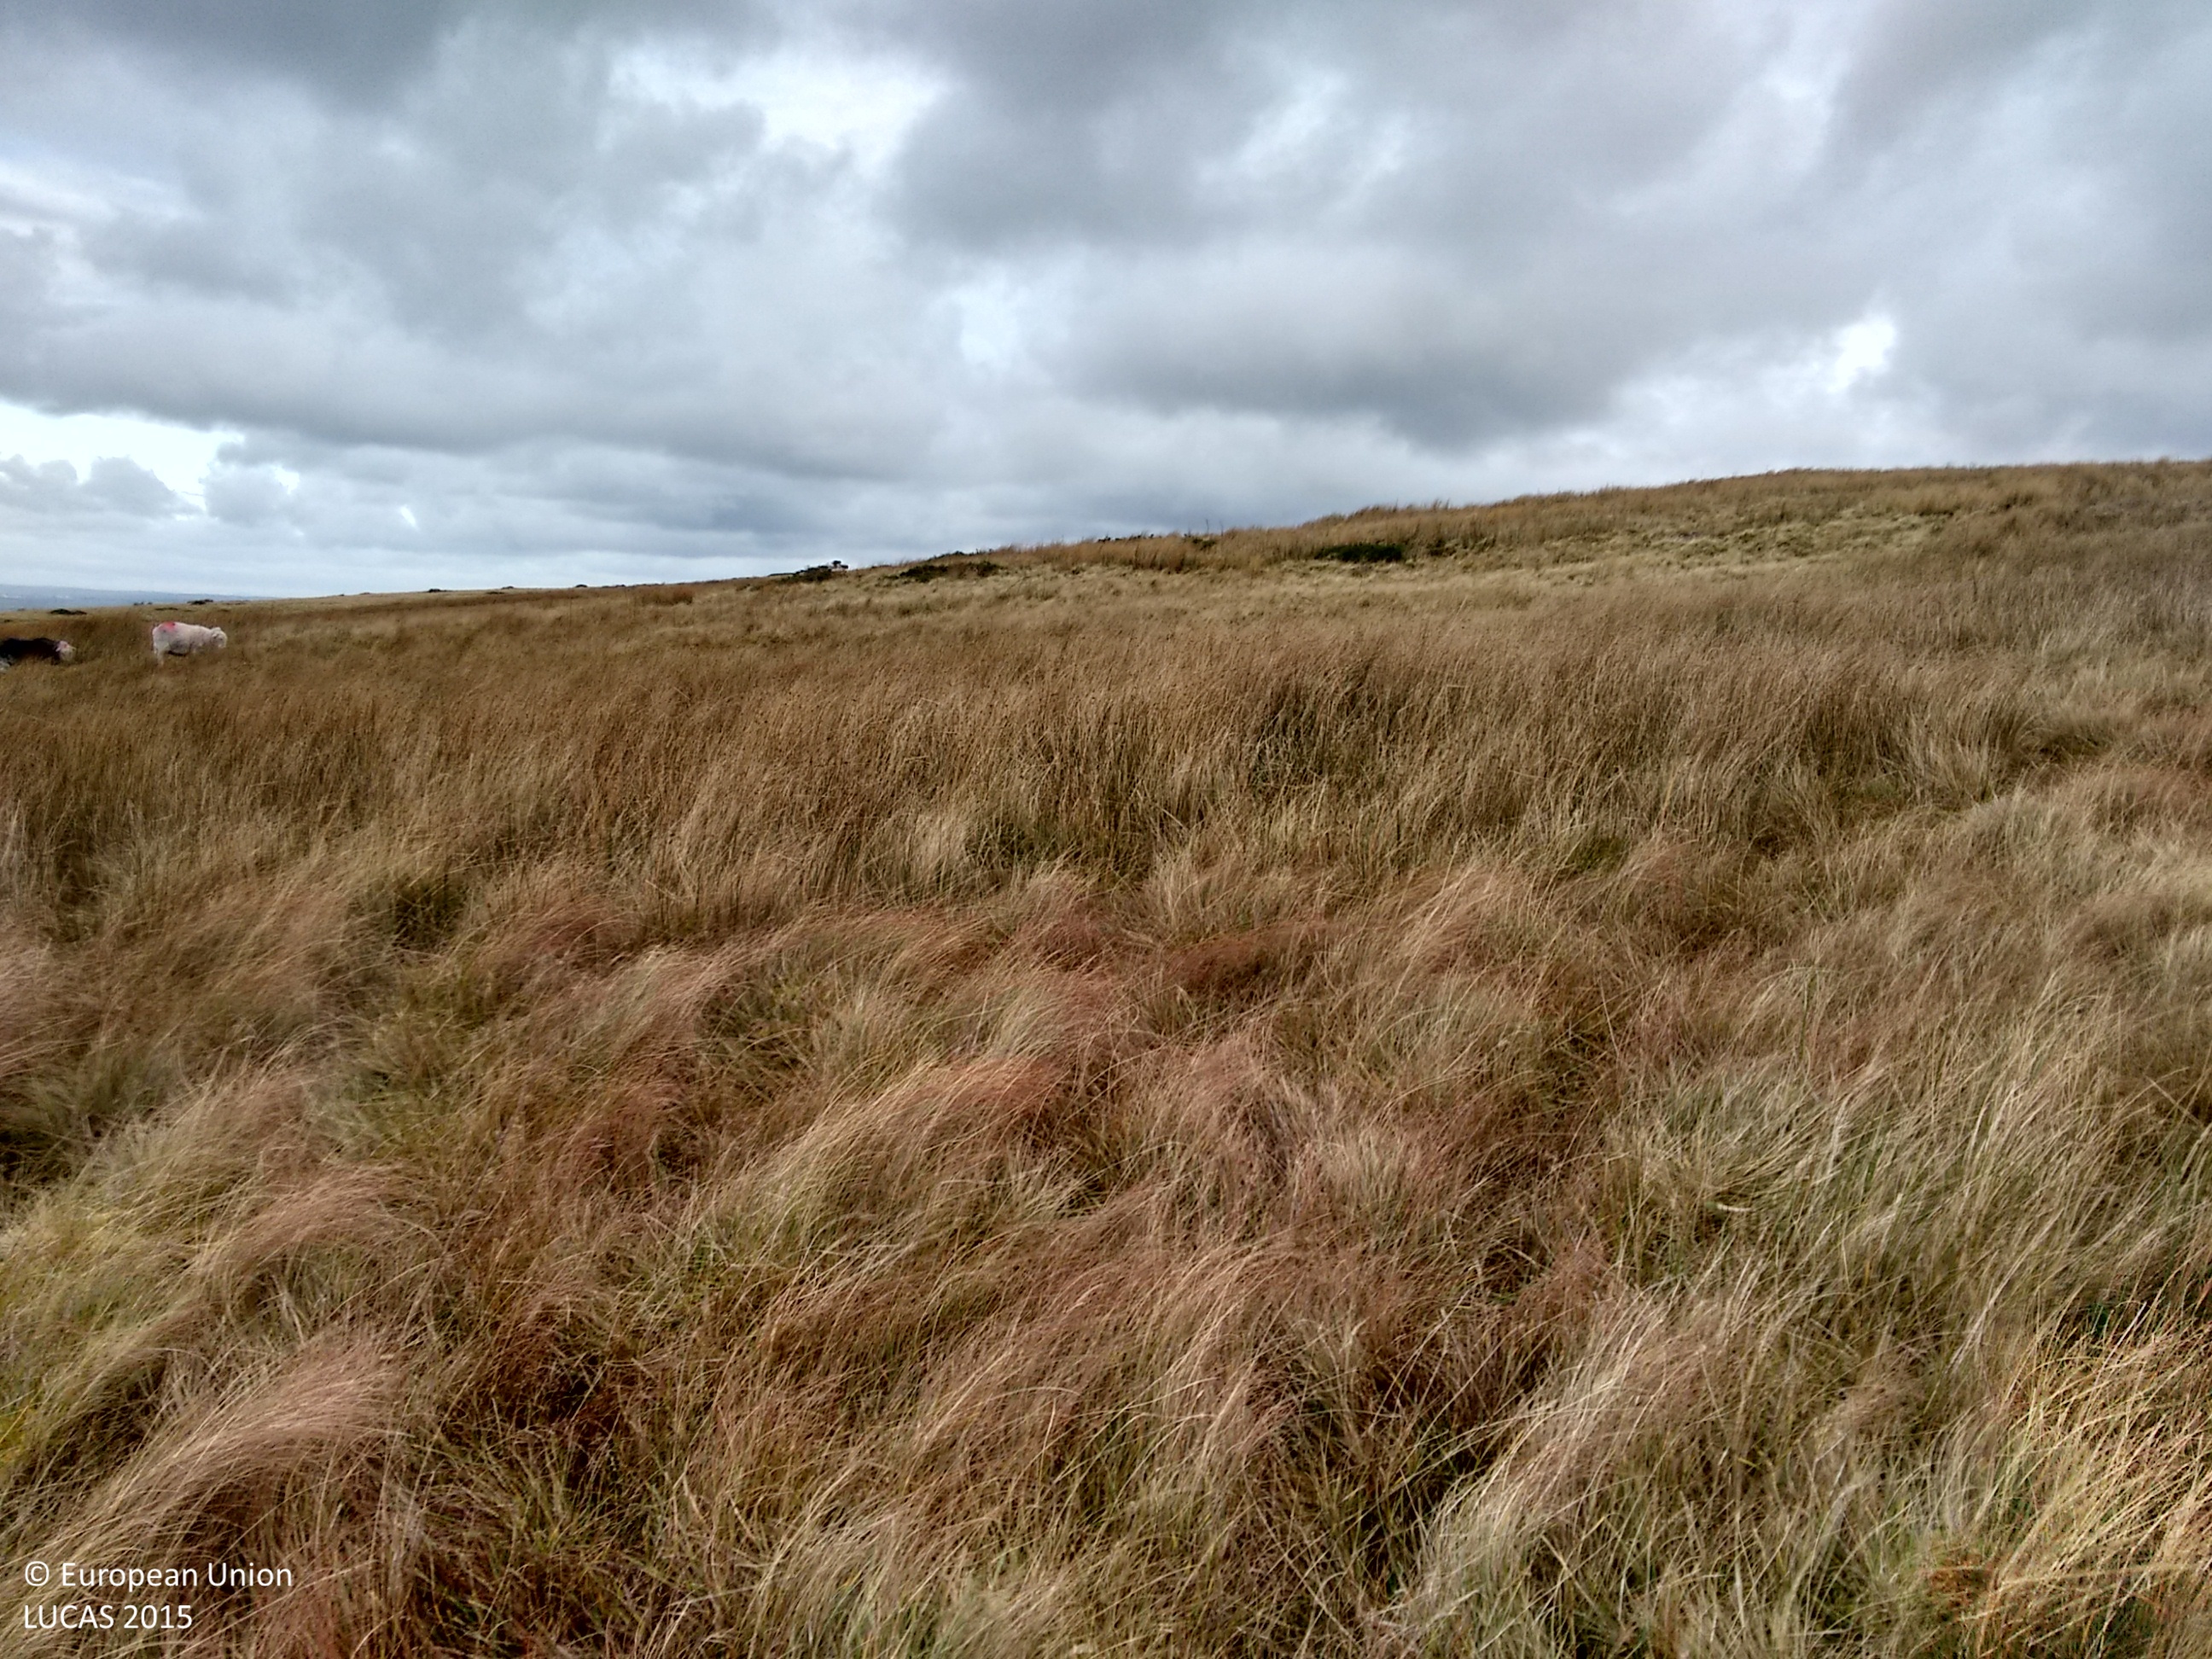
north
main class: Grassland
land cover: Grassland without tree/shrub cover
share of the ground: > 75 %
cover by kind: herbaceous plants 100 %
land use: Agriculture (excluding fallow land and kitchen gardens)
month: November
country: GB
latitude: 54.3009
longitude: -3.3407
